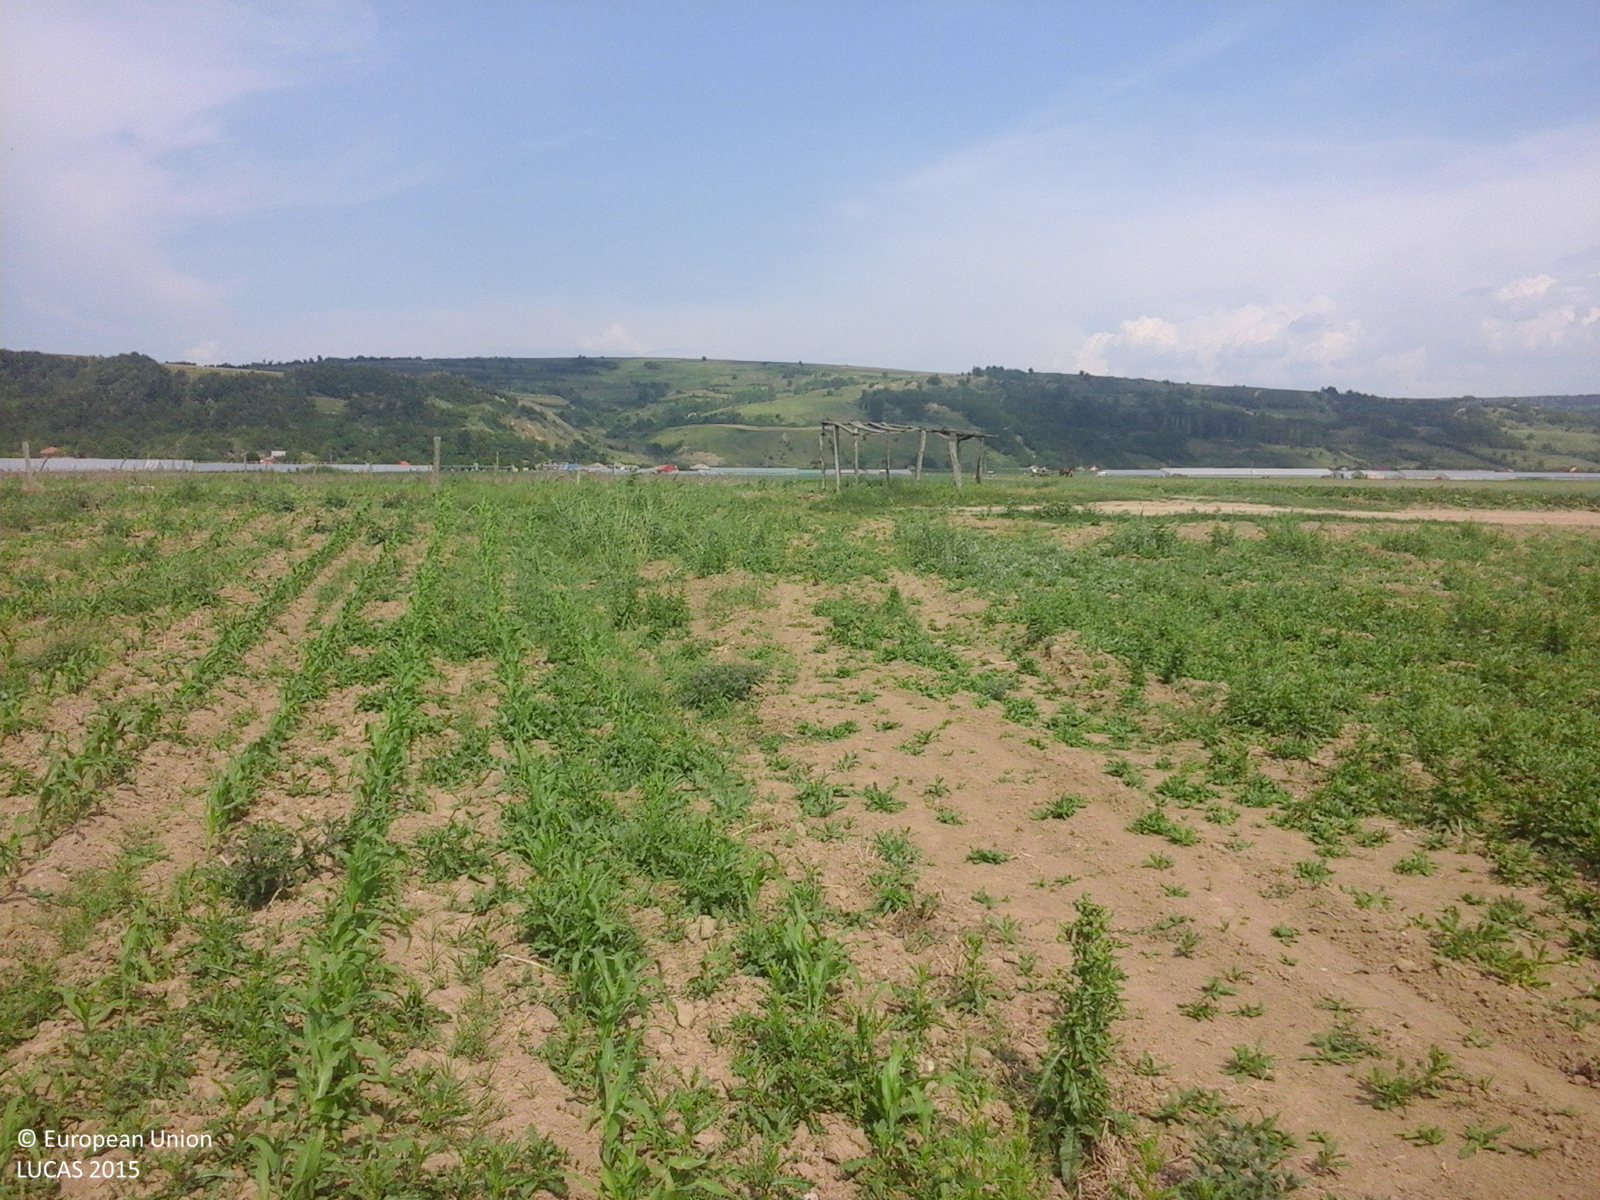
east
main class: Cropland
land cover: Maize
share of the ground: 10 - 25 %
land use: Agriculture (excluding fallow land and kitchen gardens)
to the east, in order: Maize; Grass margins; Tracks; Grass margins; Other fresh vegetables; Grass margins; Tracks; Potatoes; Other fresh vegetables; Other root crops; Tracks; Other fresh vegetables; Maize
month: June
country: RO
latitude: 46.3091
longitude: 27.0677
